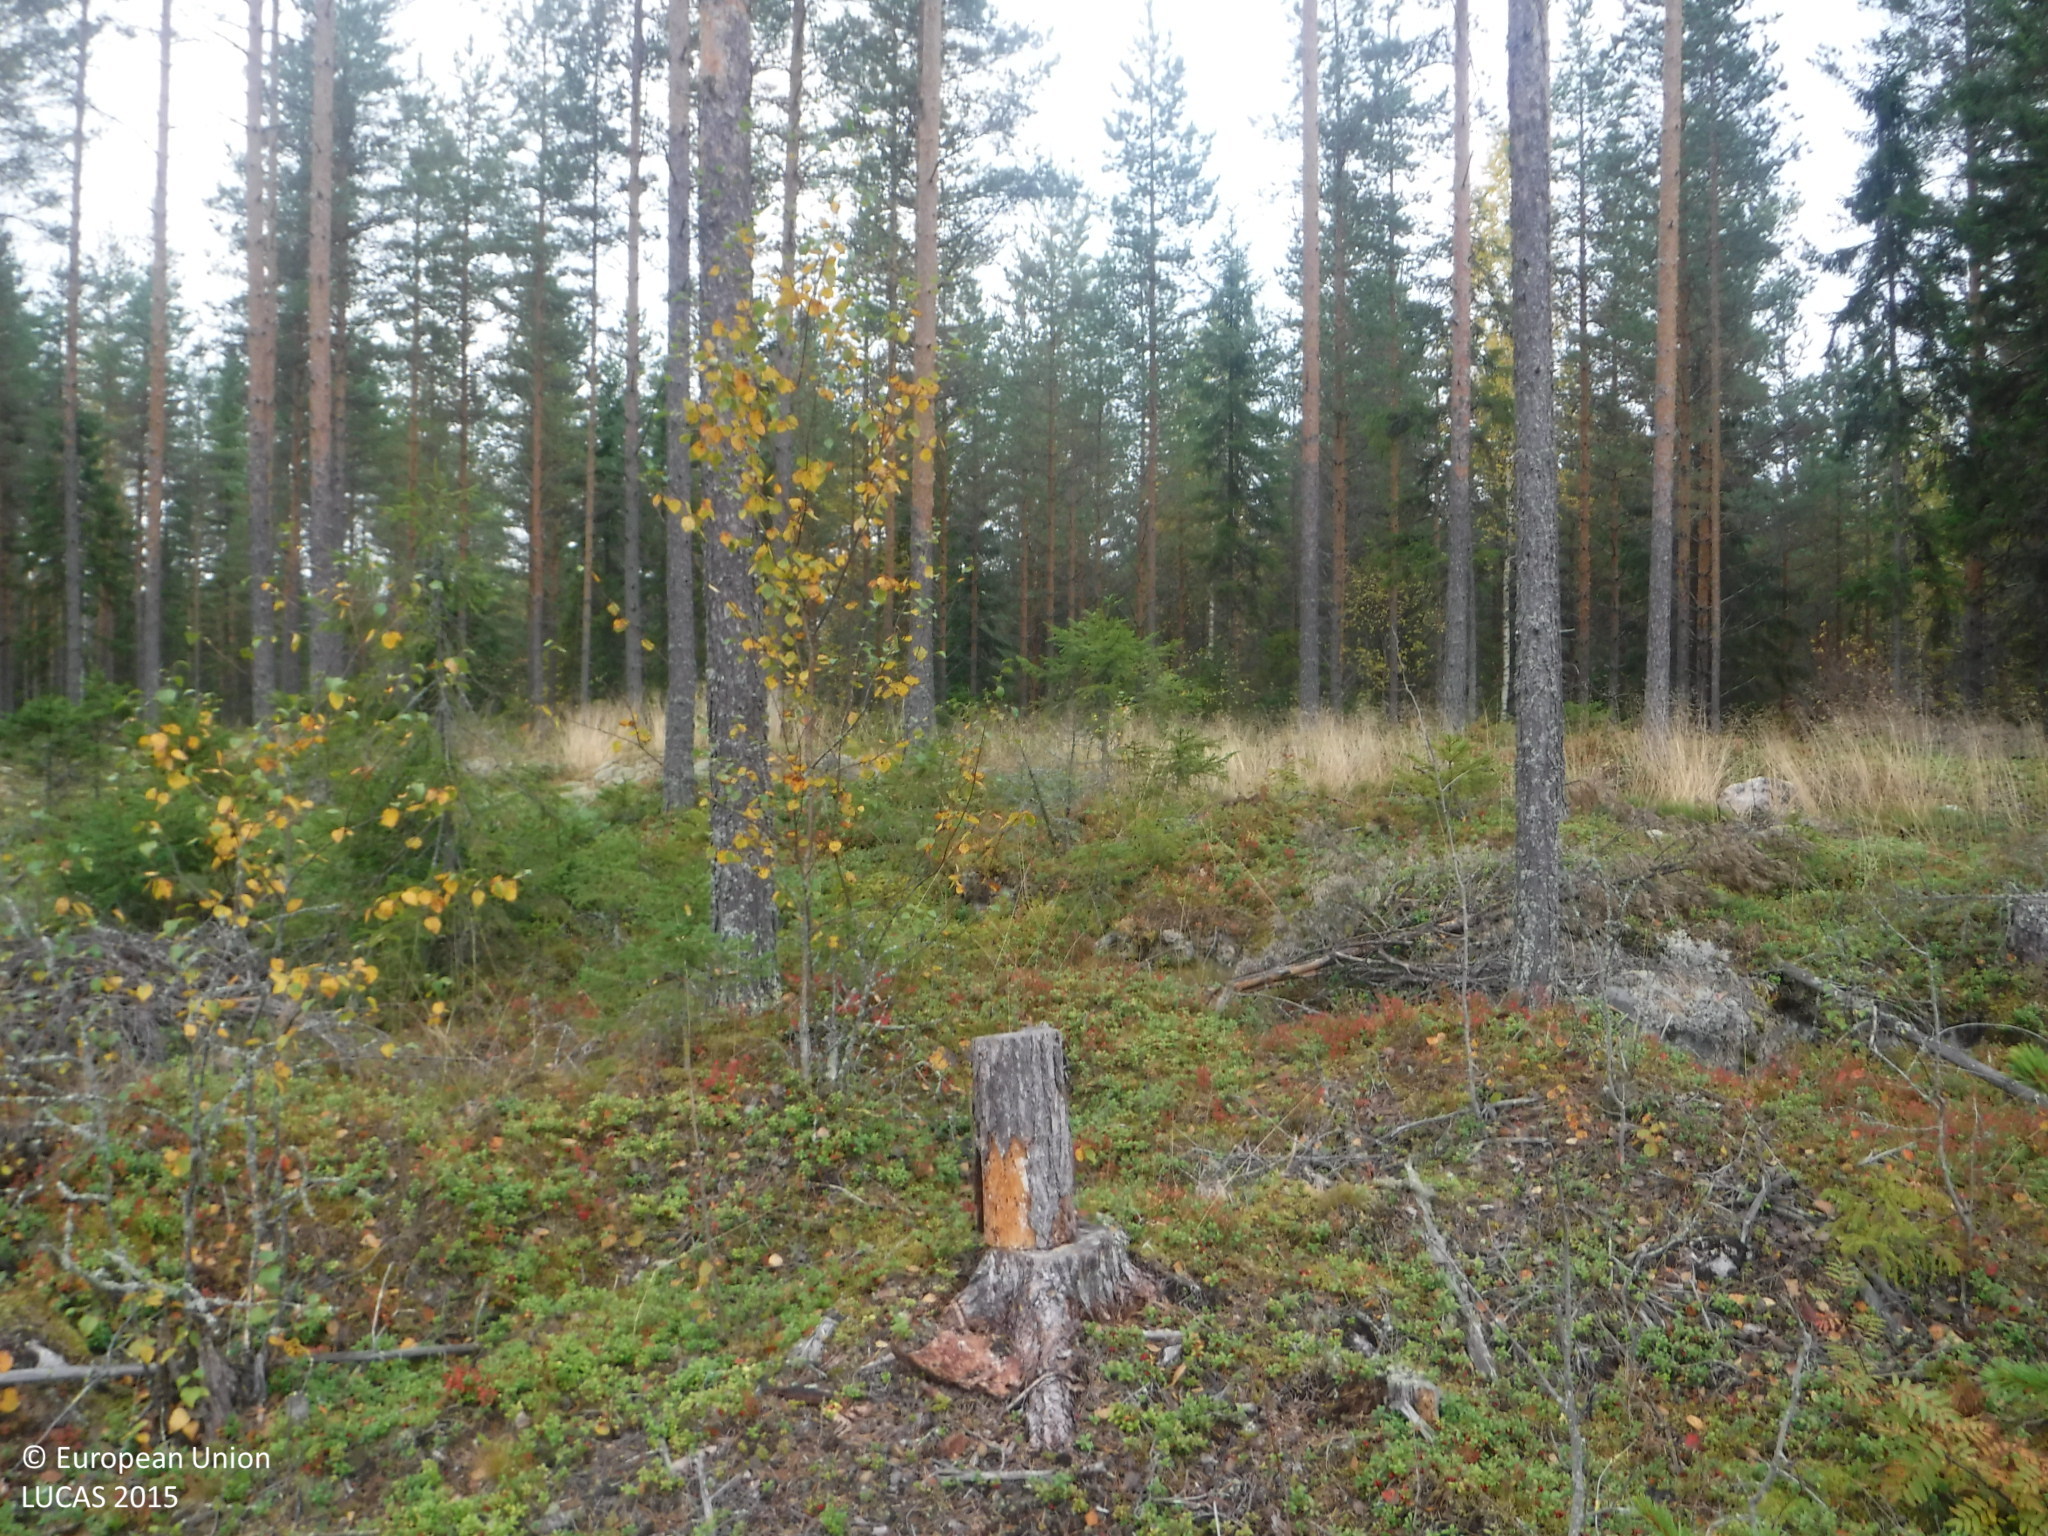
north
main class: Woodland
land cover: Pine dominated coniferous woodland
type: boreal forest
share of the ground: 10 - 25 %
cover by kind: shrubs 60 %, lichens and mosses 25 %, coniferous forest trees 15 %
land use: Forestry
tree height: > 5 m
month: September
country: FI
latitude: 61.8392
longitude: 24.0471
